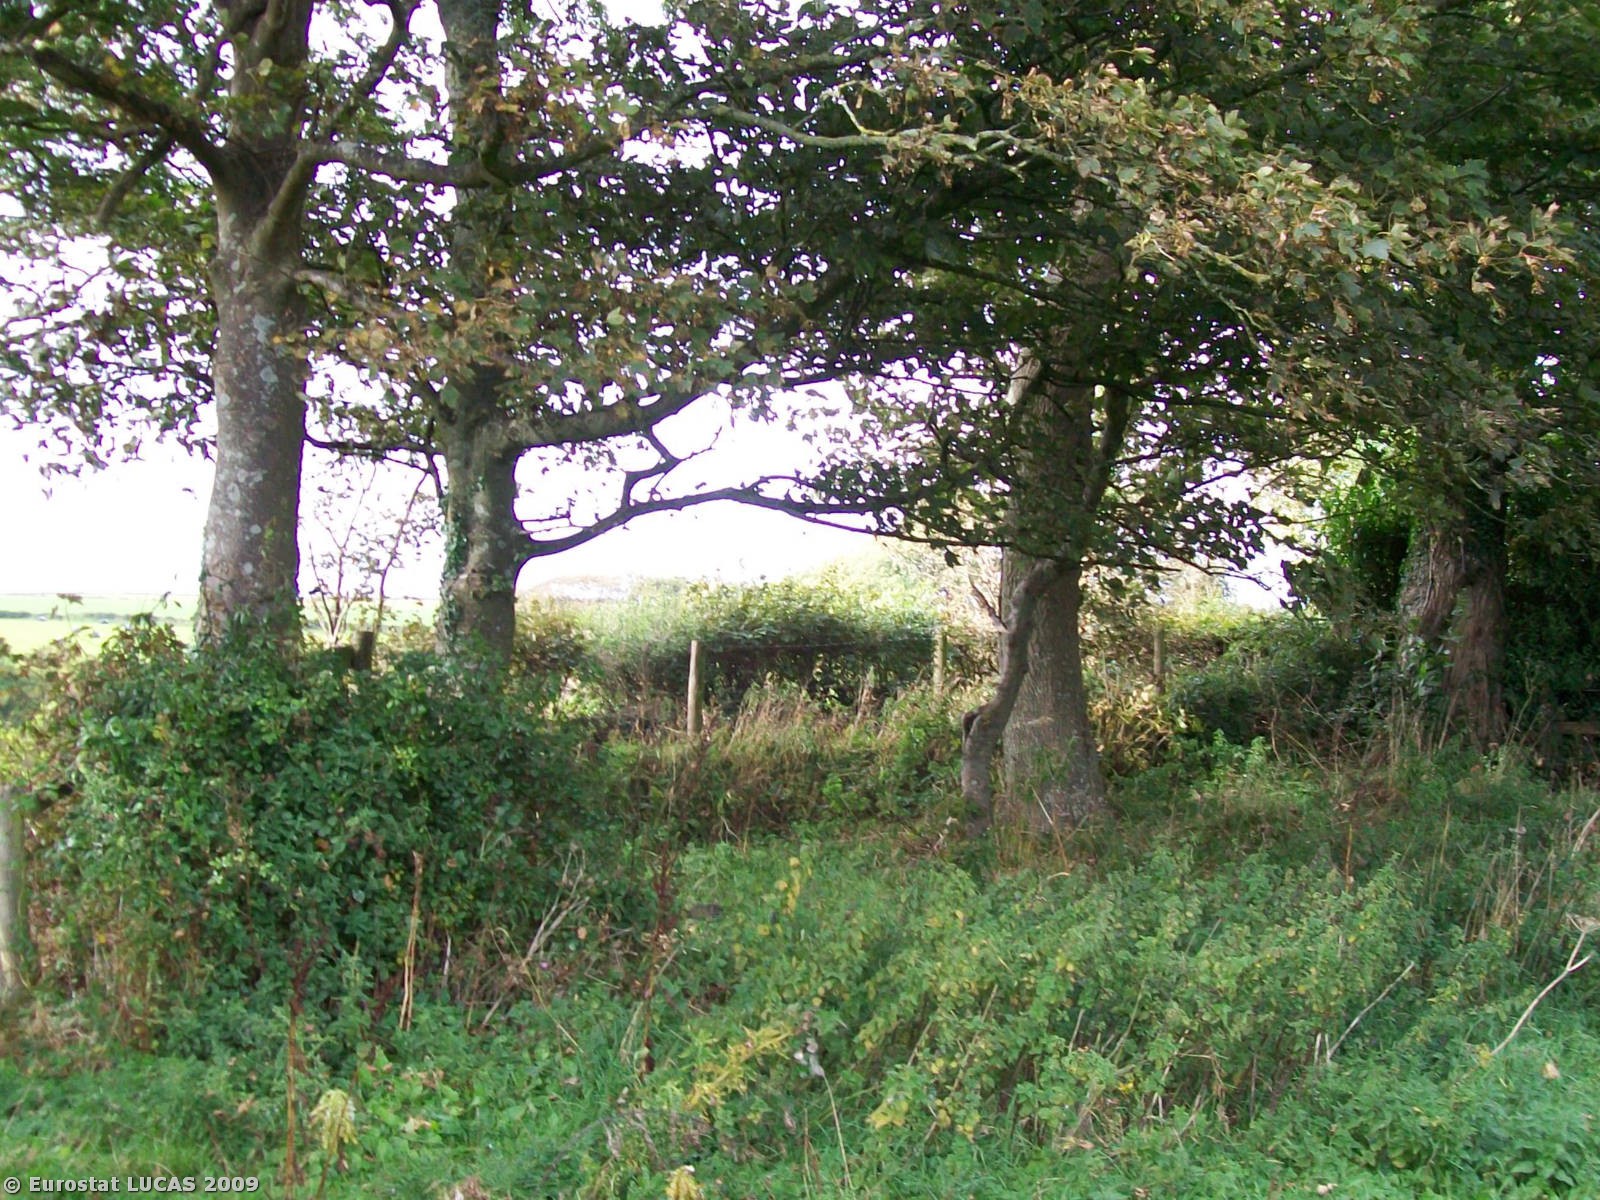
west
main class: Grassland
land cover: Grassland without tree/shrub cover
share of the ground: > 75 %
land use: Agriculture (excluding fallow land and kitchen gardens)
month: September
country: GB
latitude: 52.0257
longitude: -4.8182
